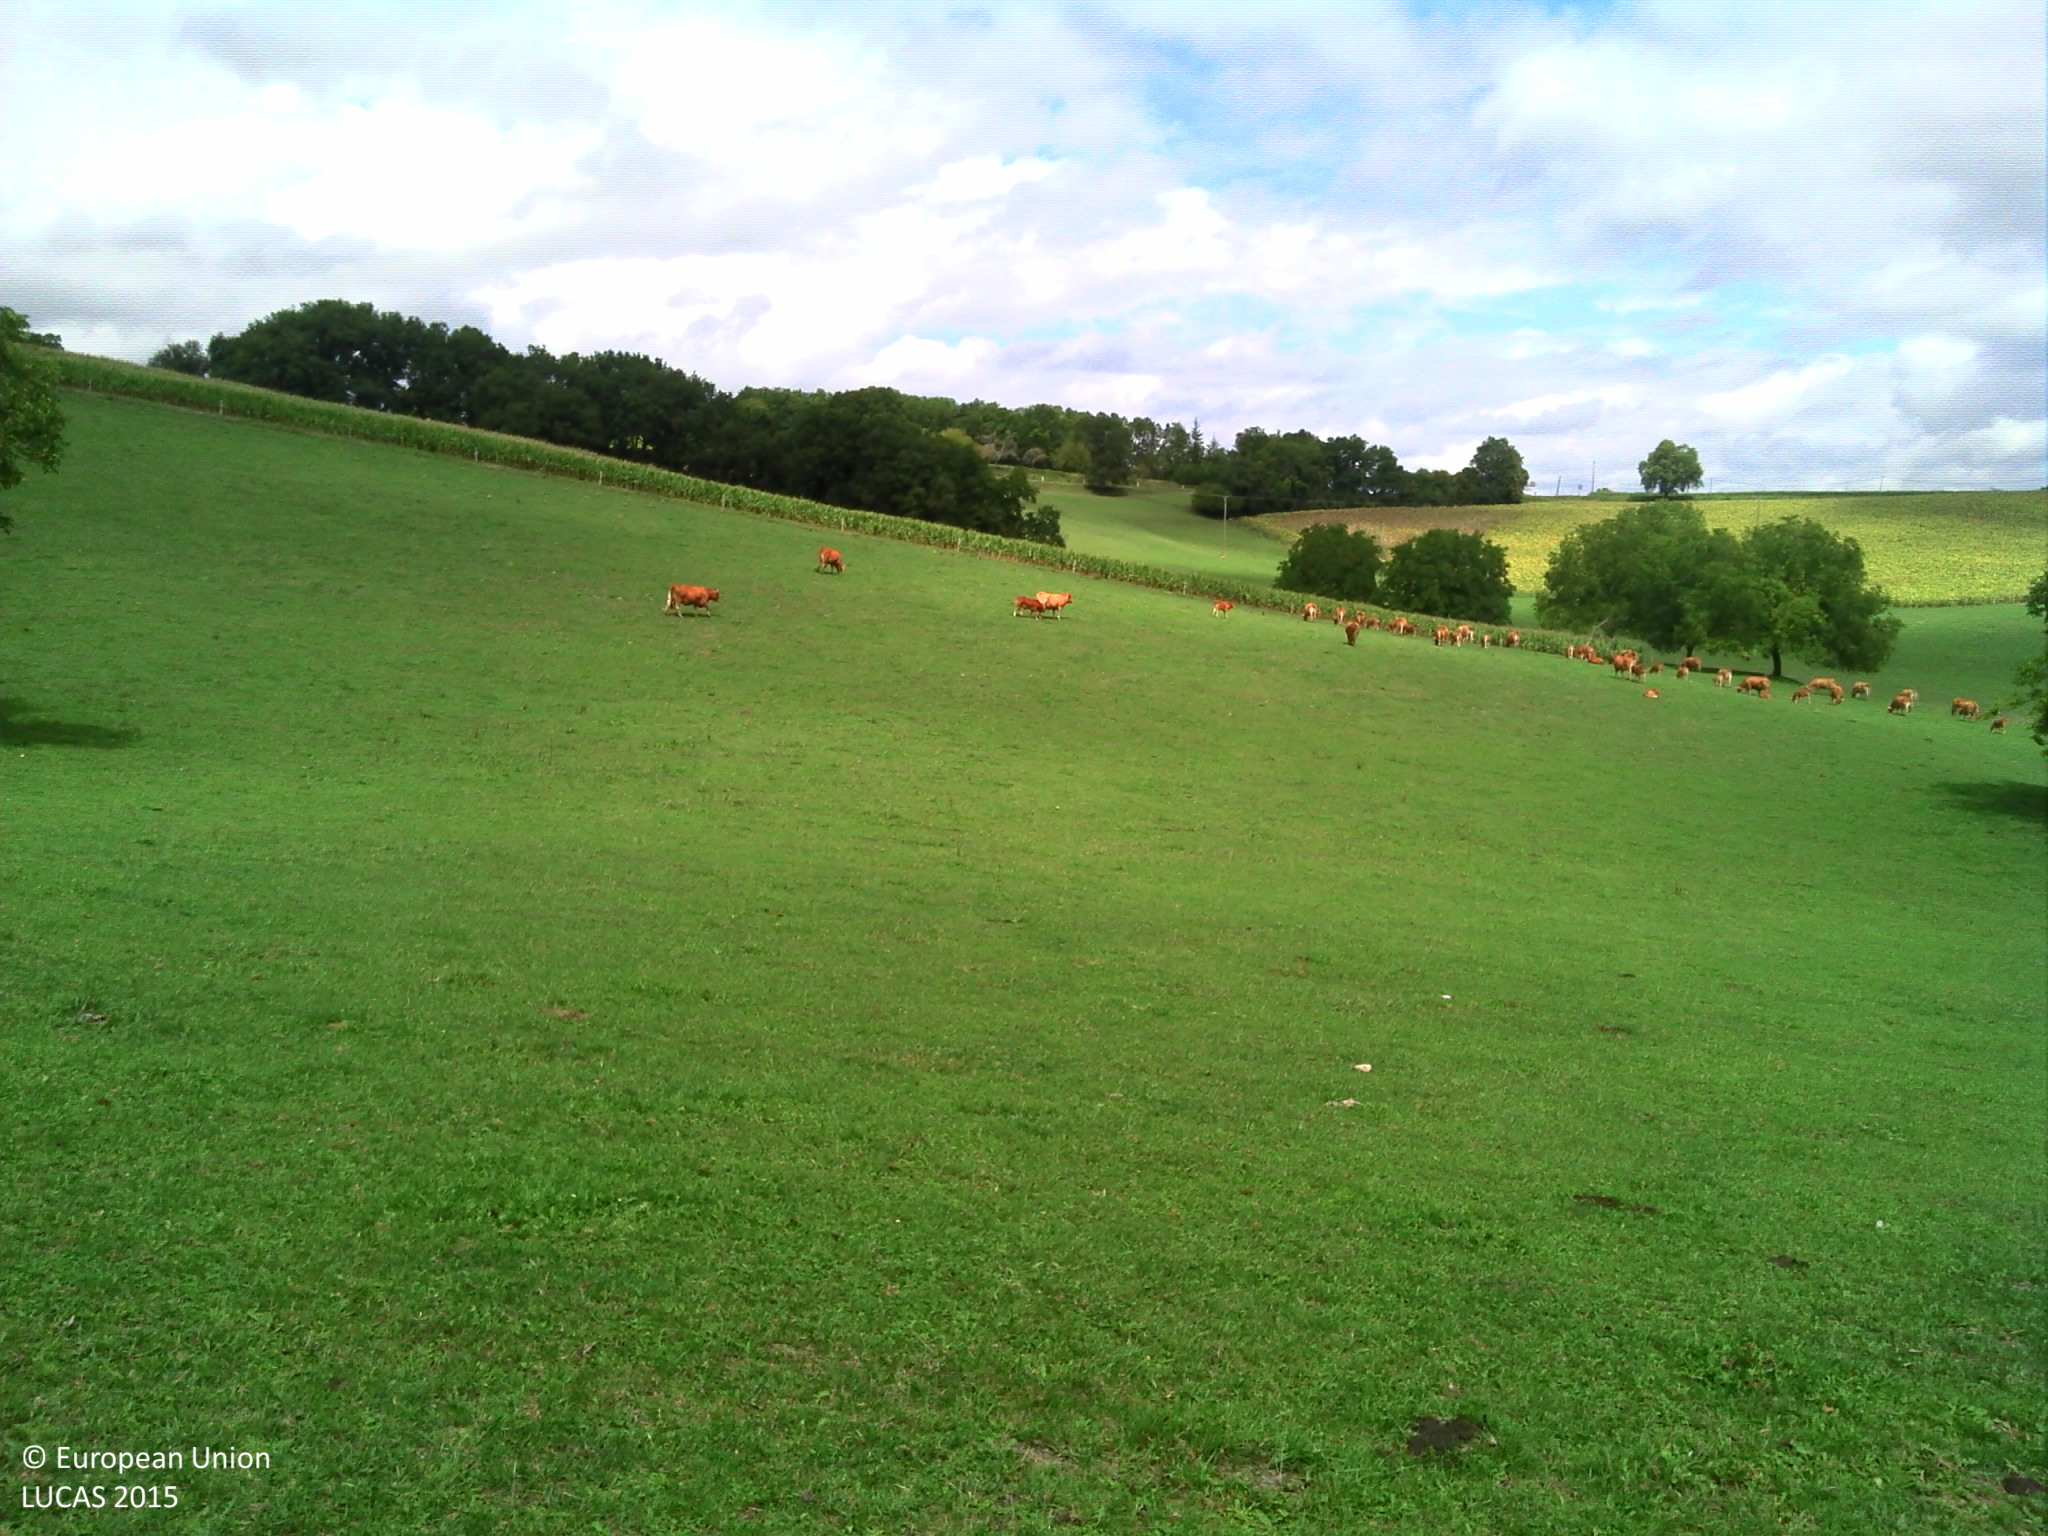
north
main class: Grassland
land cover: Grassland without tree/shrub cover
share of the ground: > 75 %
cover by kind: herbaceous plants 80 %, lichens and mosses 20 %
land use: Agriculture (excluding fallow land and kitchen gardens)
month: August
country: FR
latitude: 45.2918
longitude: 0.4887
